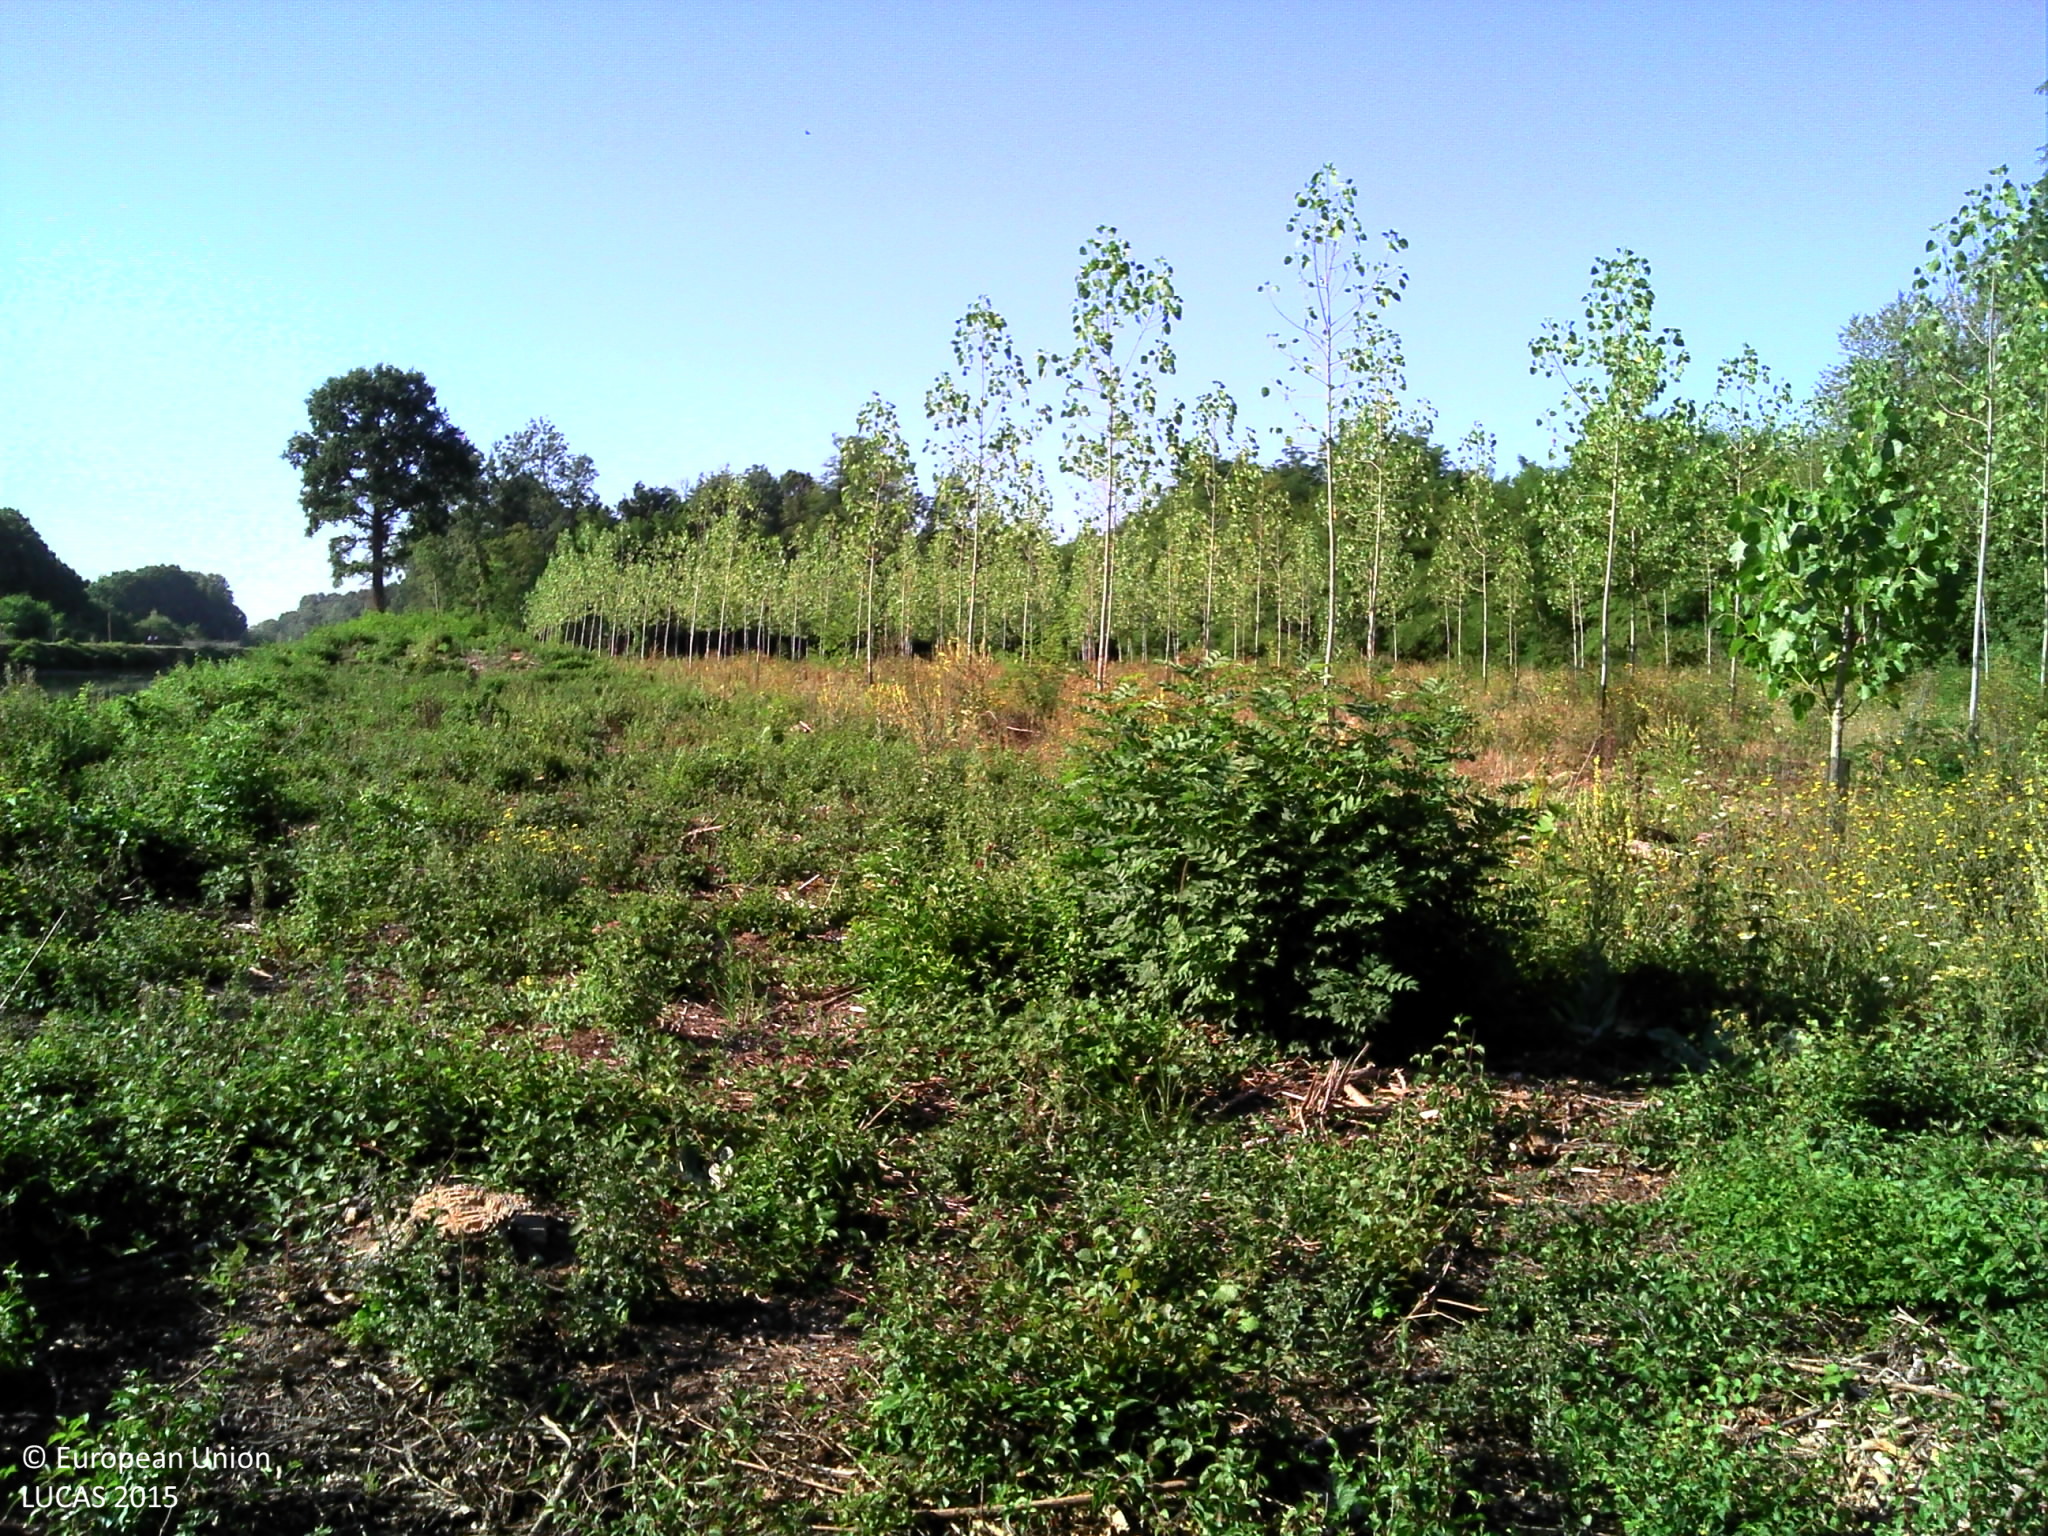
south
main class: Shrubland
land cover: Shrubland with sparse tree cover
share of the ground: > 75 %
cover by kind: herbaceous plants 65 %, shrubs 30 %, broadleaved forest trees 5 %
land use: Semi-natural and natural areas not in use
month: August
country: FR
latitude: 47.9073
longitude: 3.5334
